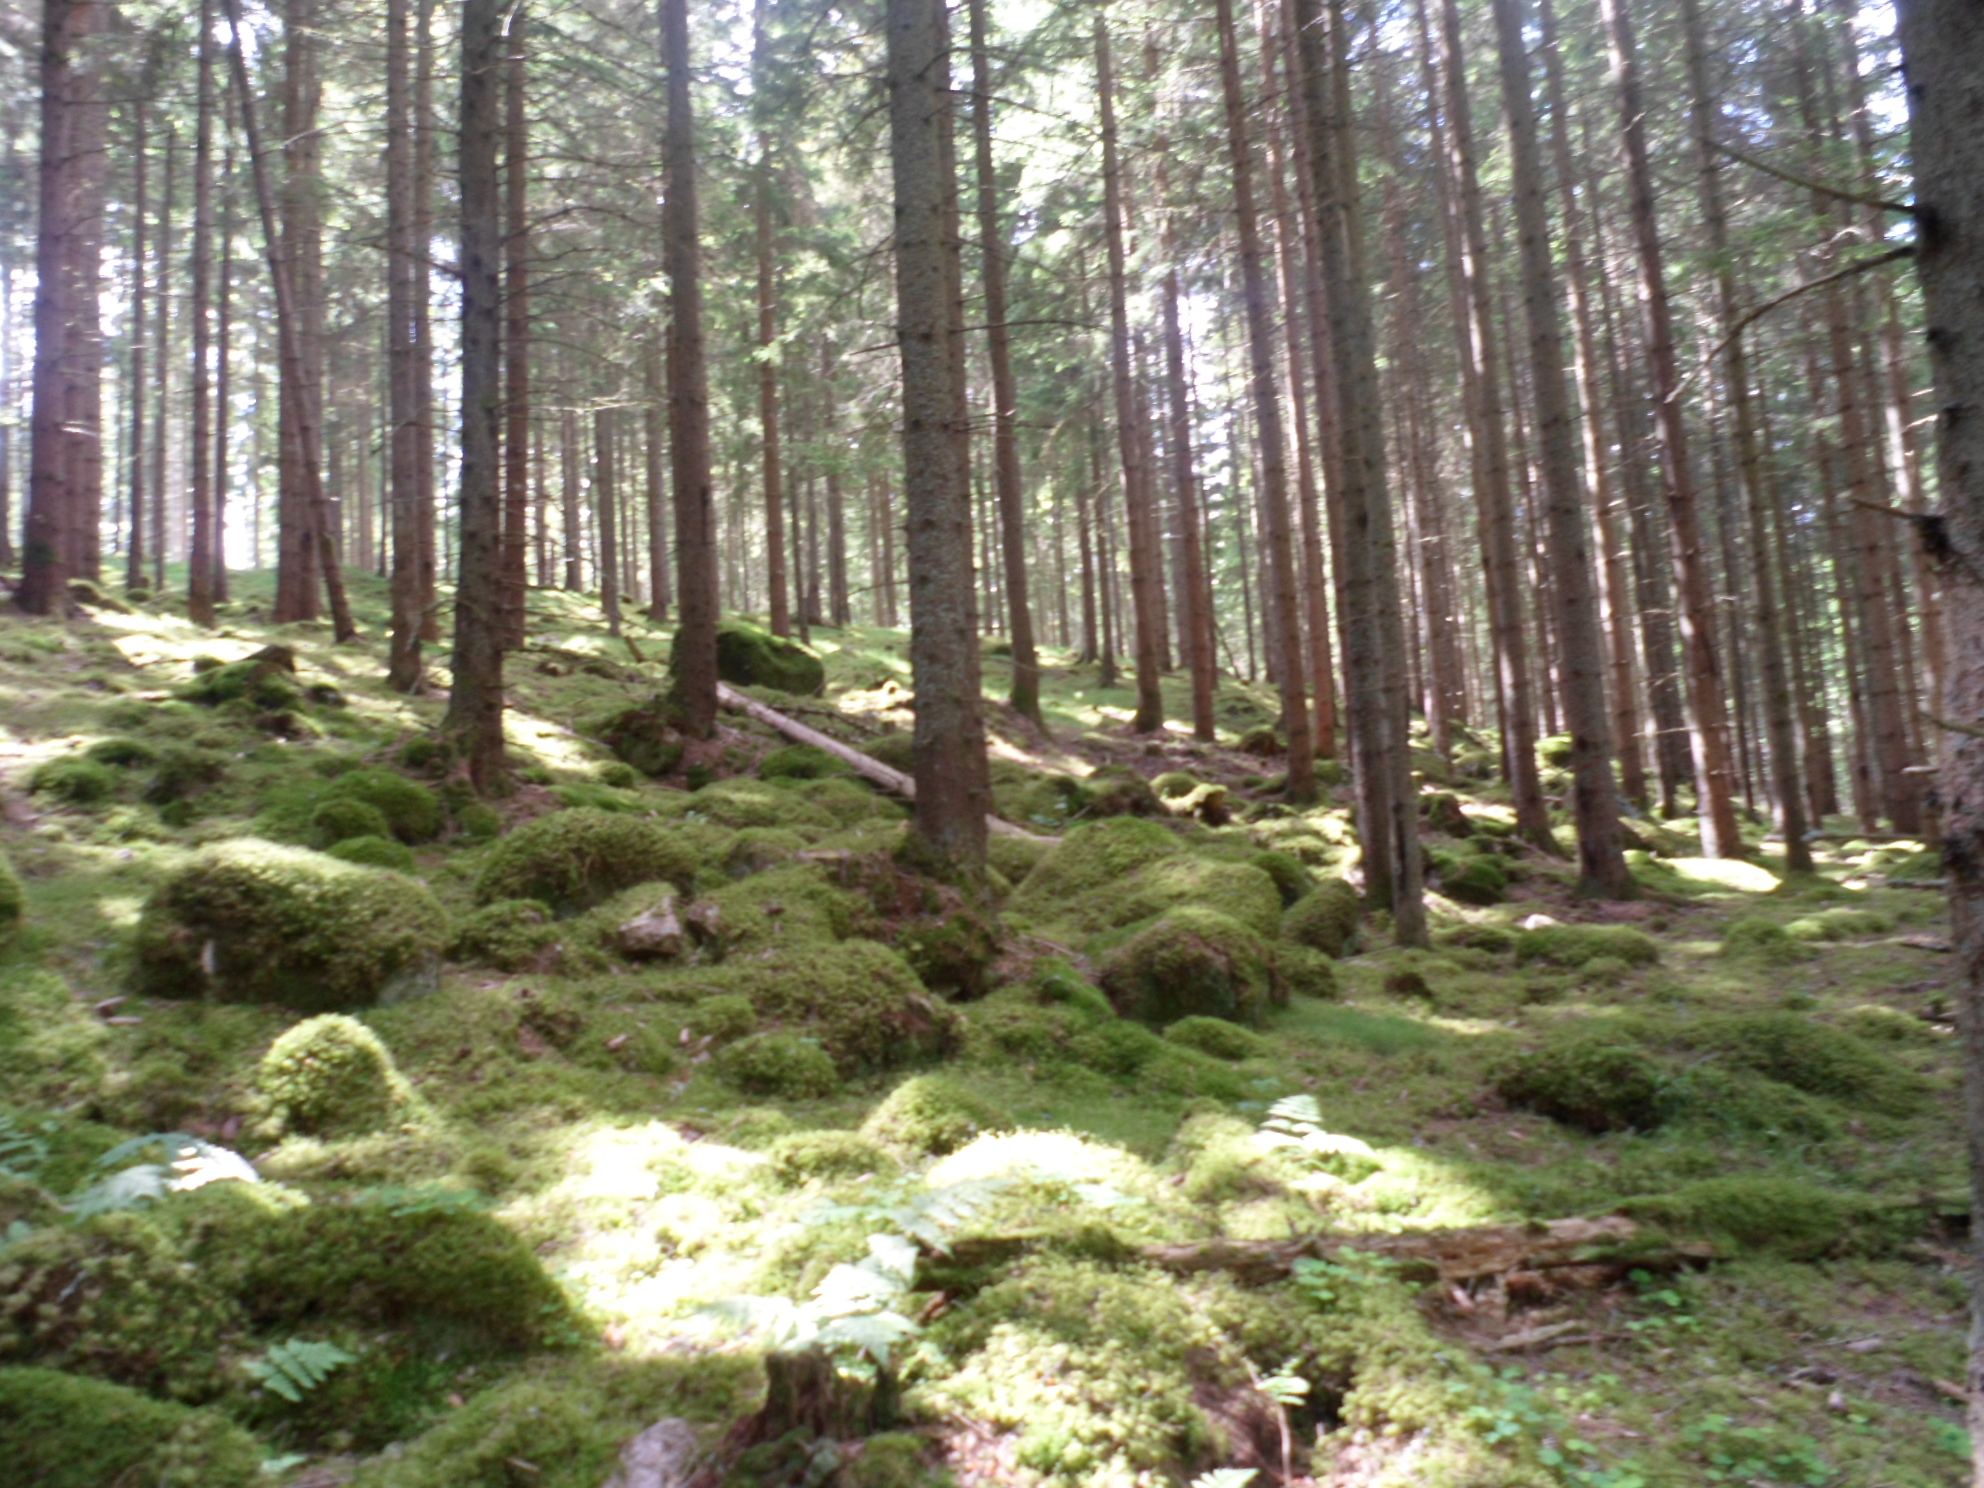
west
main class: Woodland
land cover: Spruce dominated coniferous woodland
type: boreal forest
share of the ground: > 75 %
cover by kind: coniferous forest trees 75 %, lichens and mosses 15 %, shrubs 5 %, herbaceous plants 5 %
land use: Forestry
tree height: > 5 m
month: June
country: SE
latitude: 57.1438
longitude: 14.7728
